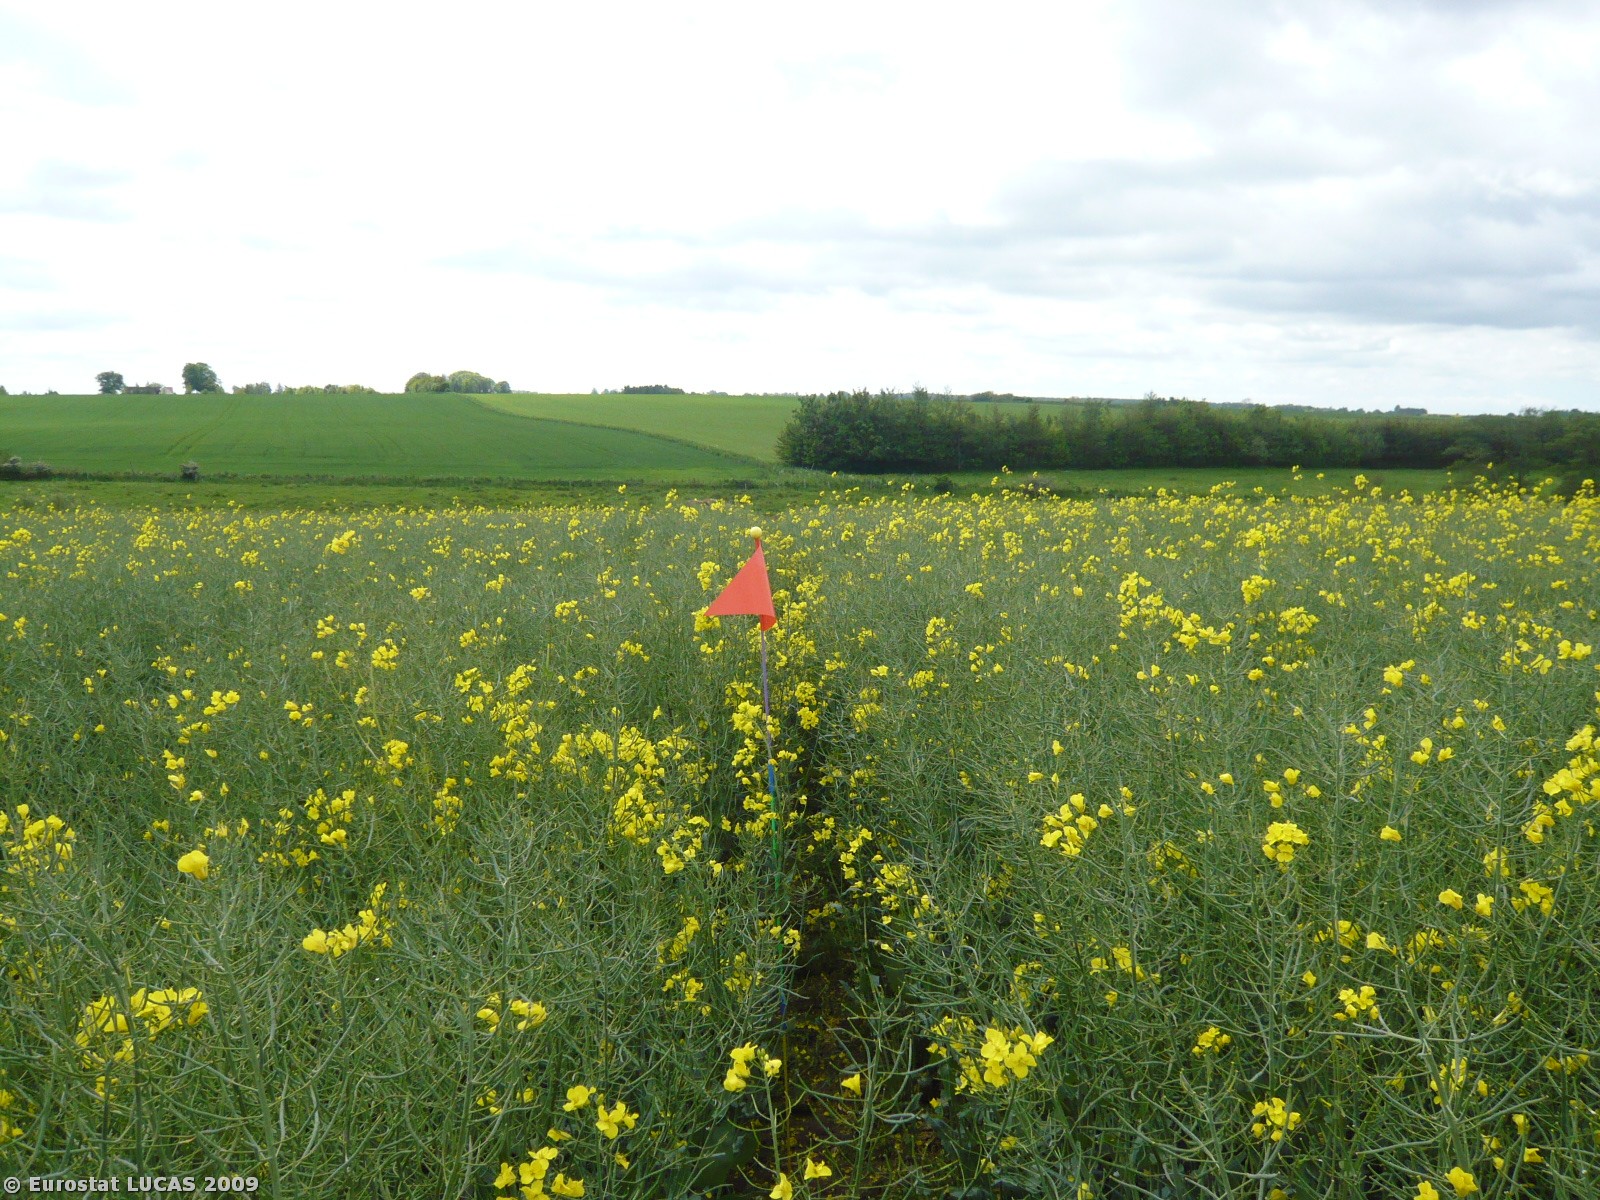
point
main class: Cropland
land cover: Rape and turnip rape
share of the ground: > 75 %
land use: Agriculture (excluding fallow land and kitchen gardens)
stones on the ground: < 10 %
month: May
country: DK
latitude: 55.4215
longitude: 11.6891
